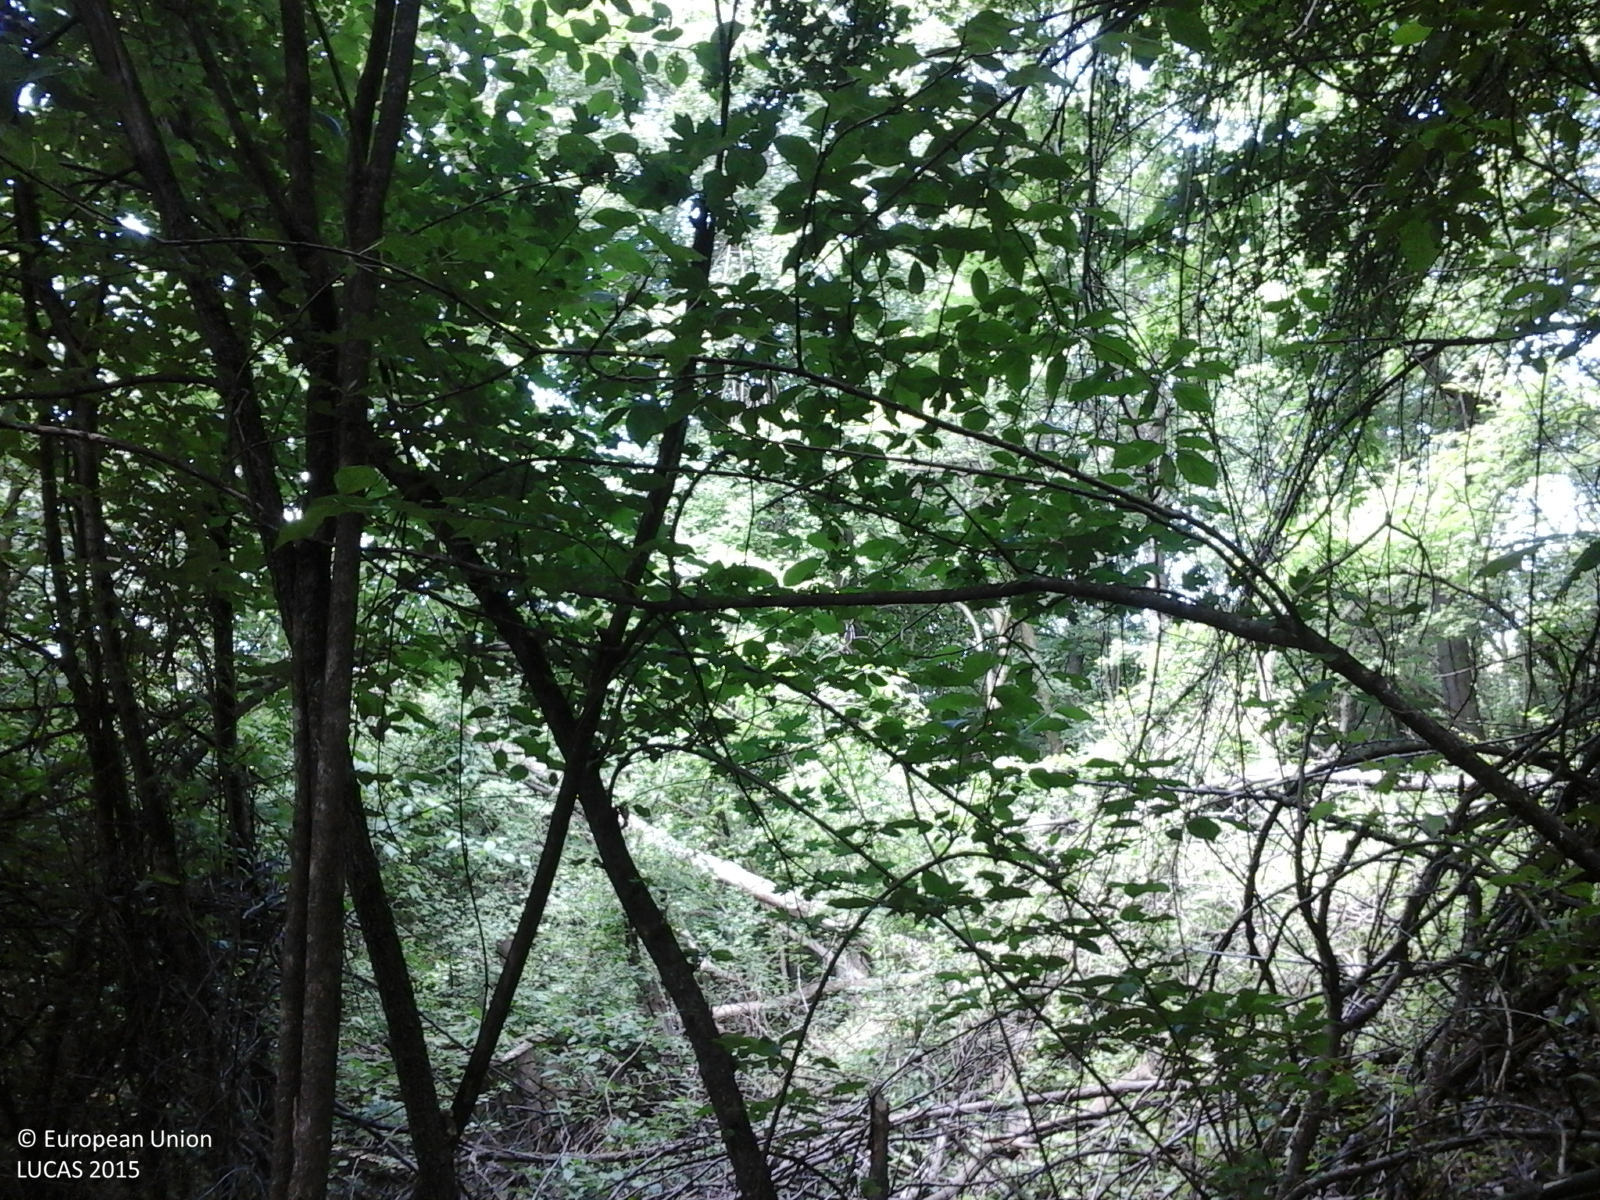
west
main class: Woodland
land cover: Broadleaved woodland
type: non-riverine alder, birch or aspen forest
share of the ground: > 75 %
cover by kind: broadleaved forest trees 100 %
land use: Forestry
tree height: > 5 m
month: May
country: RO
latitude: 45.2318
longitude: 26.0981
